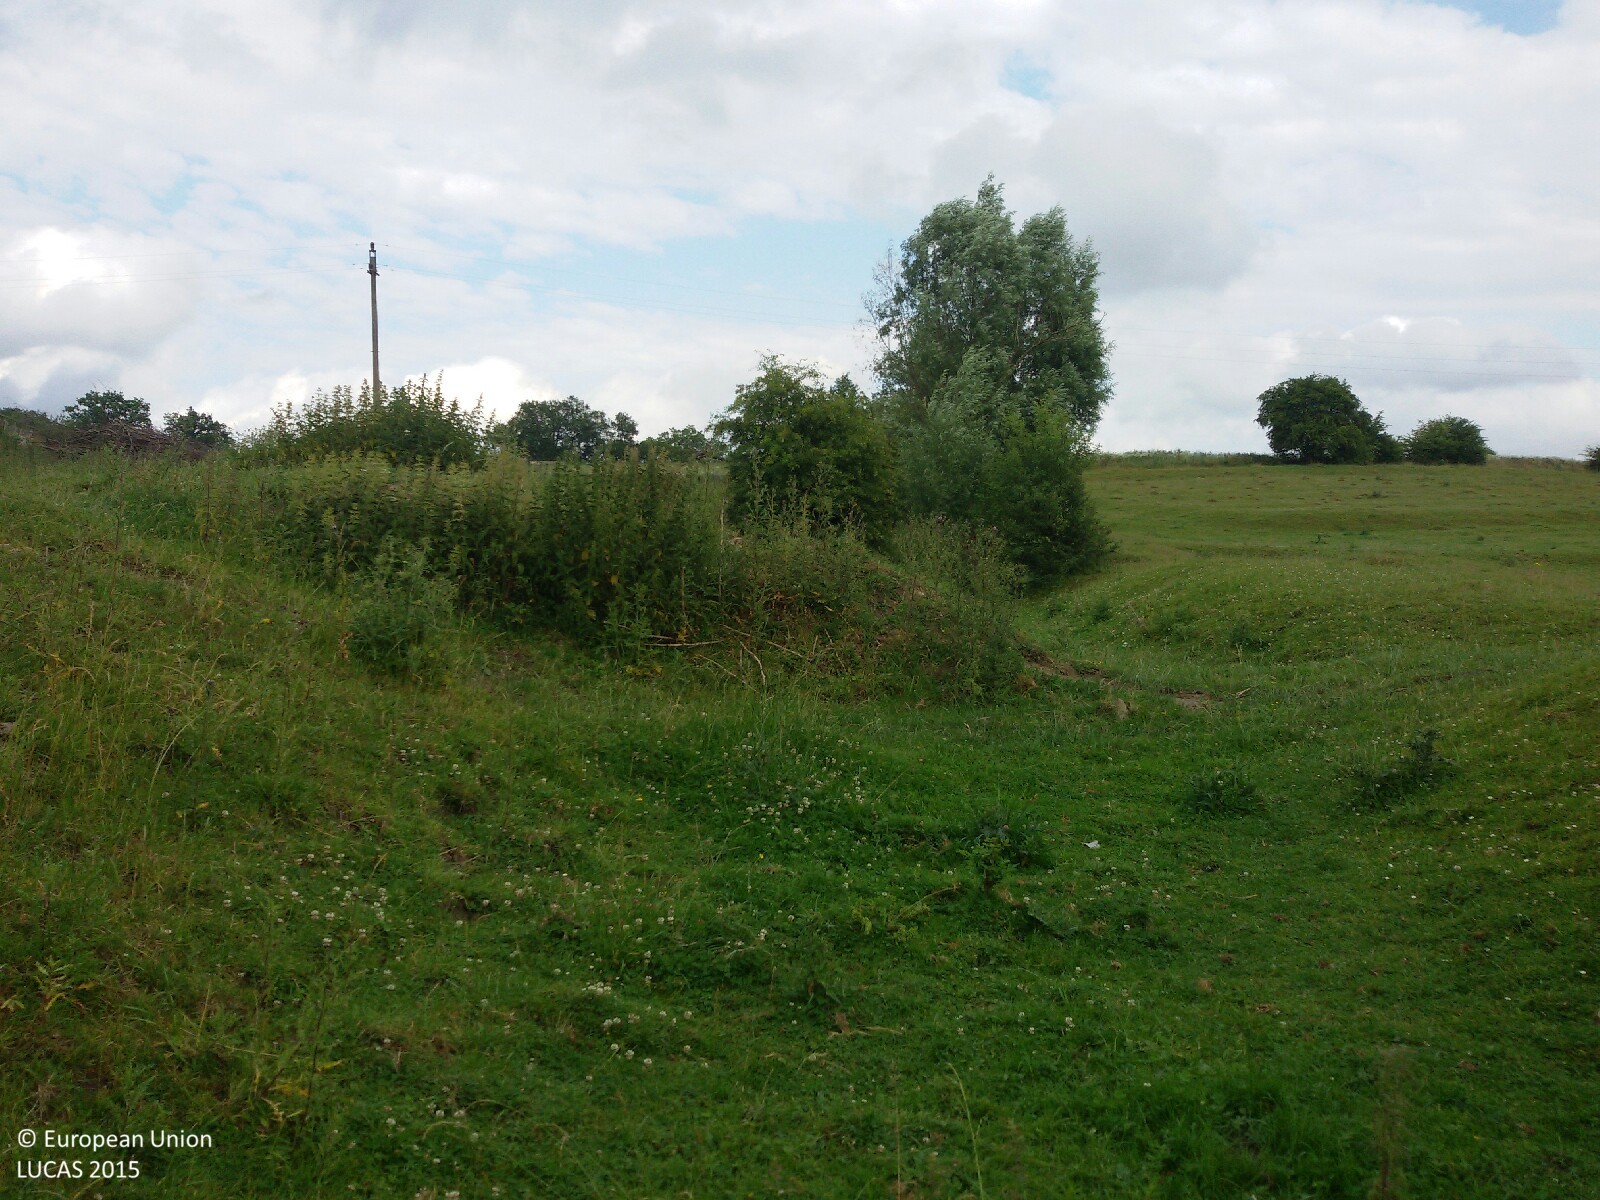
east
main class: Grassland
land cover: Grassland without tree/shrub cover
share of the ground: > 75 %
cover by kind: herbaceous plants 90 %, shrubs 5 %, unconsolidated bare surface 5 %
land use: Agriculture (excluding fallow land and kitchen gardens)
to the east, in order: Grassland without tree/shrub cover; Single bushes/trees; Grassland without tree/shrub cover; Electric lines; Grassland without tree/shrub cover; Single bushes/trees; Grassland without tree/shrub cover; Fences; Other leguminous and mixtures for fodder; Fences; Grassland without tree/shrub cover; Fences; Mixed cereals for fodder
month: July
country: PL
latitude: 54.0863
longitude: 20.2918
